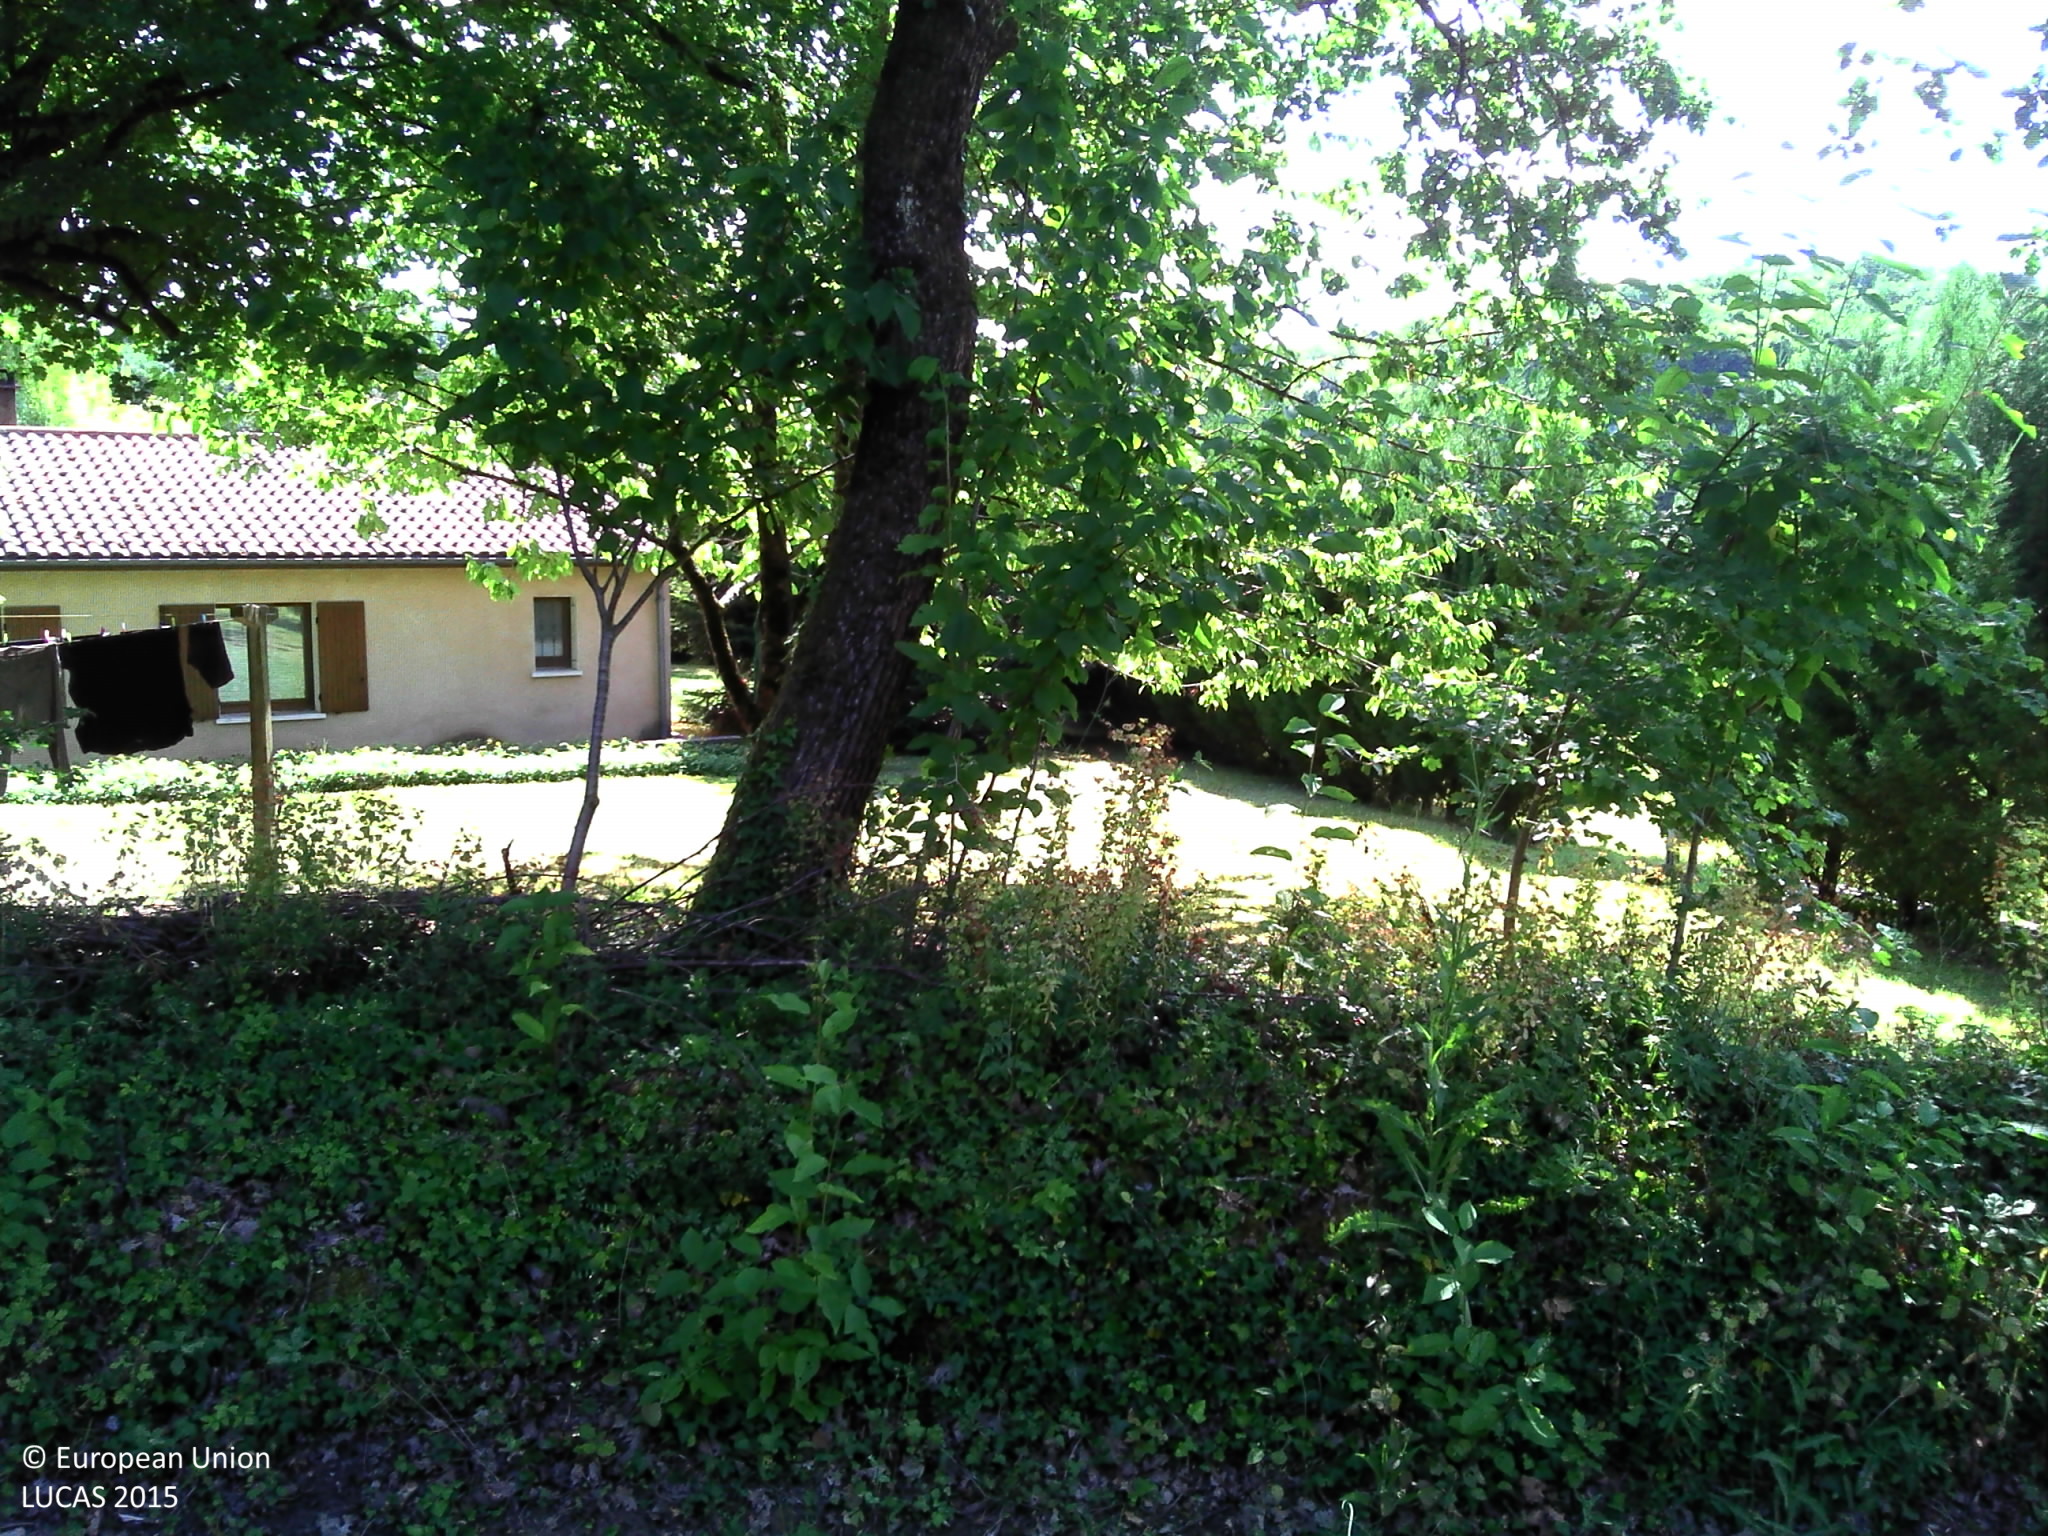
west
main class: Woodland
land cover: Broadleaved woodland
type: thermophilous deciduous forest
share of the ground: > 75 %
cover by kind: broadleaved forest trees 65 %, shrubs 30 %, herbaceous plants 5 %
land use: Forestry
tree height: > 5 m
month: June
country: FR
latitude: 45.6846
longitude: 0.4200
